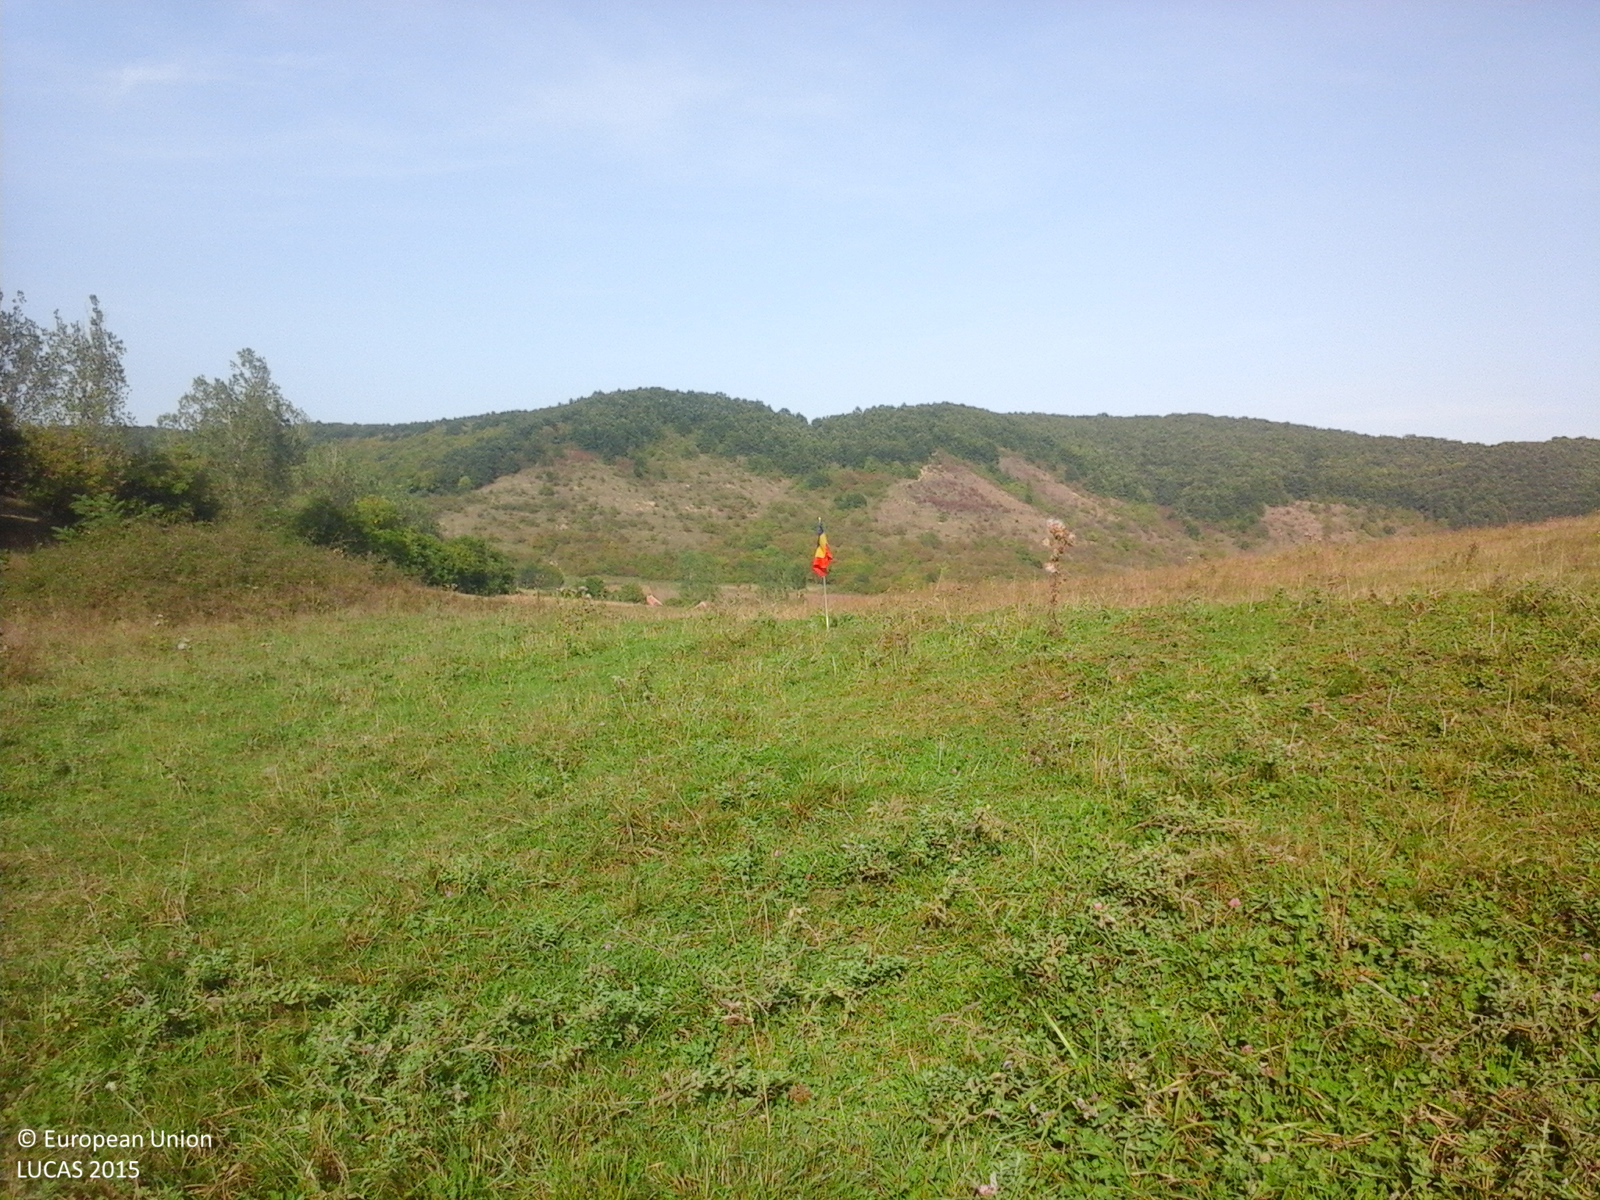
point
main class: Grassland
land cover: Grassland without tree/shrub cover
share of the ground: > 75 %
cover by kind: herbaceous plants 100 %
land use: Agriculture (excluding fallow land and kitchen gardens)
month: September
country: RO
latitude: 47.0184
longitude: 23.3957
